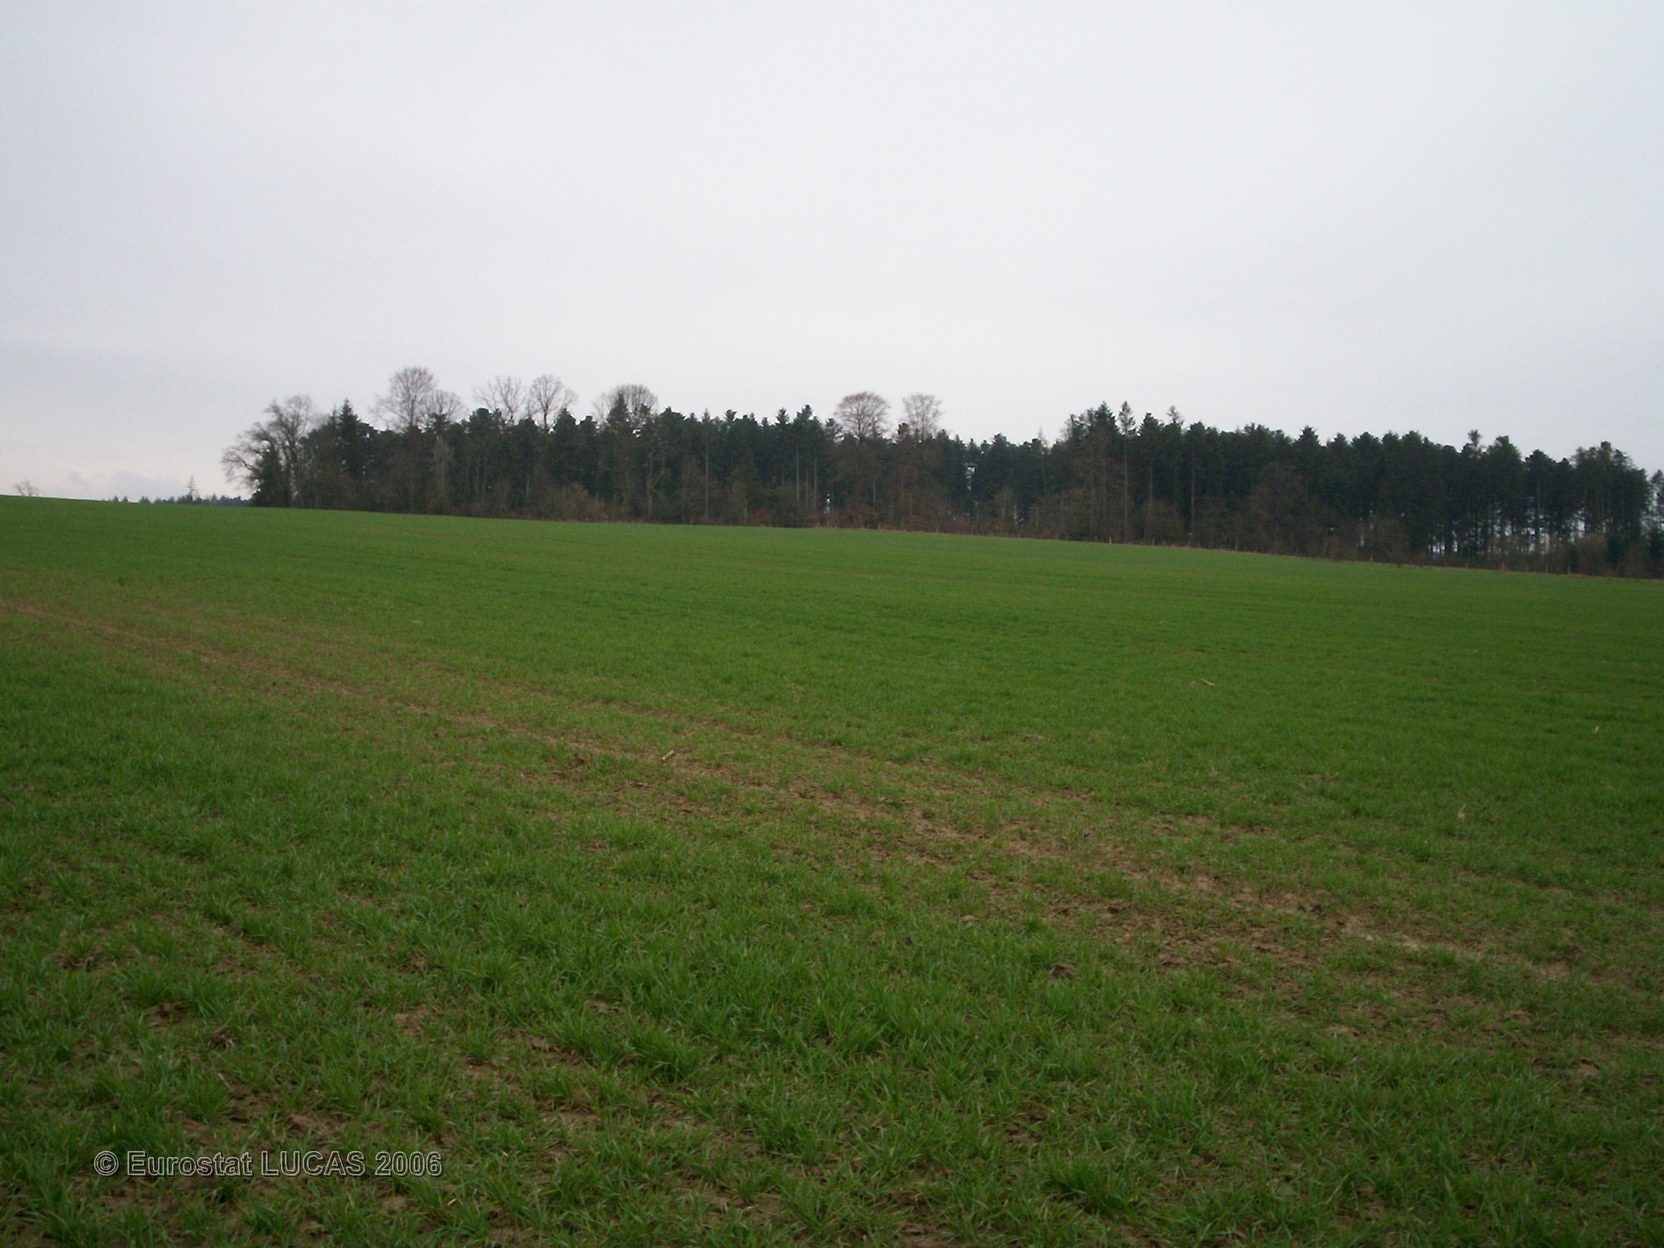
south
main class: Cropland
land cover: Common wheat
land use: Agriculture (excluding fallow land and kitchen gardens)
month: April
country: FR
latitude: 48.6329
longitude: 7.0018
